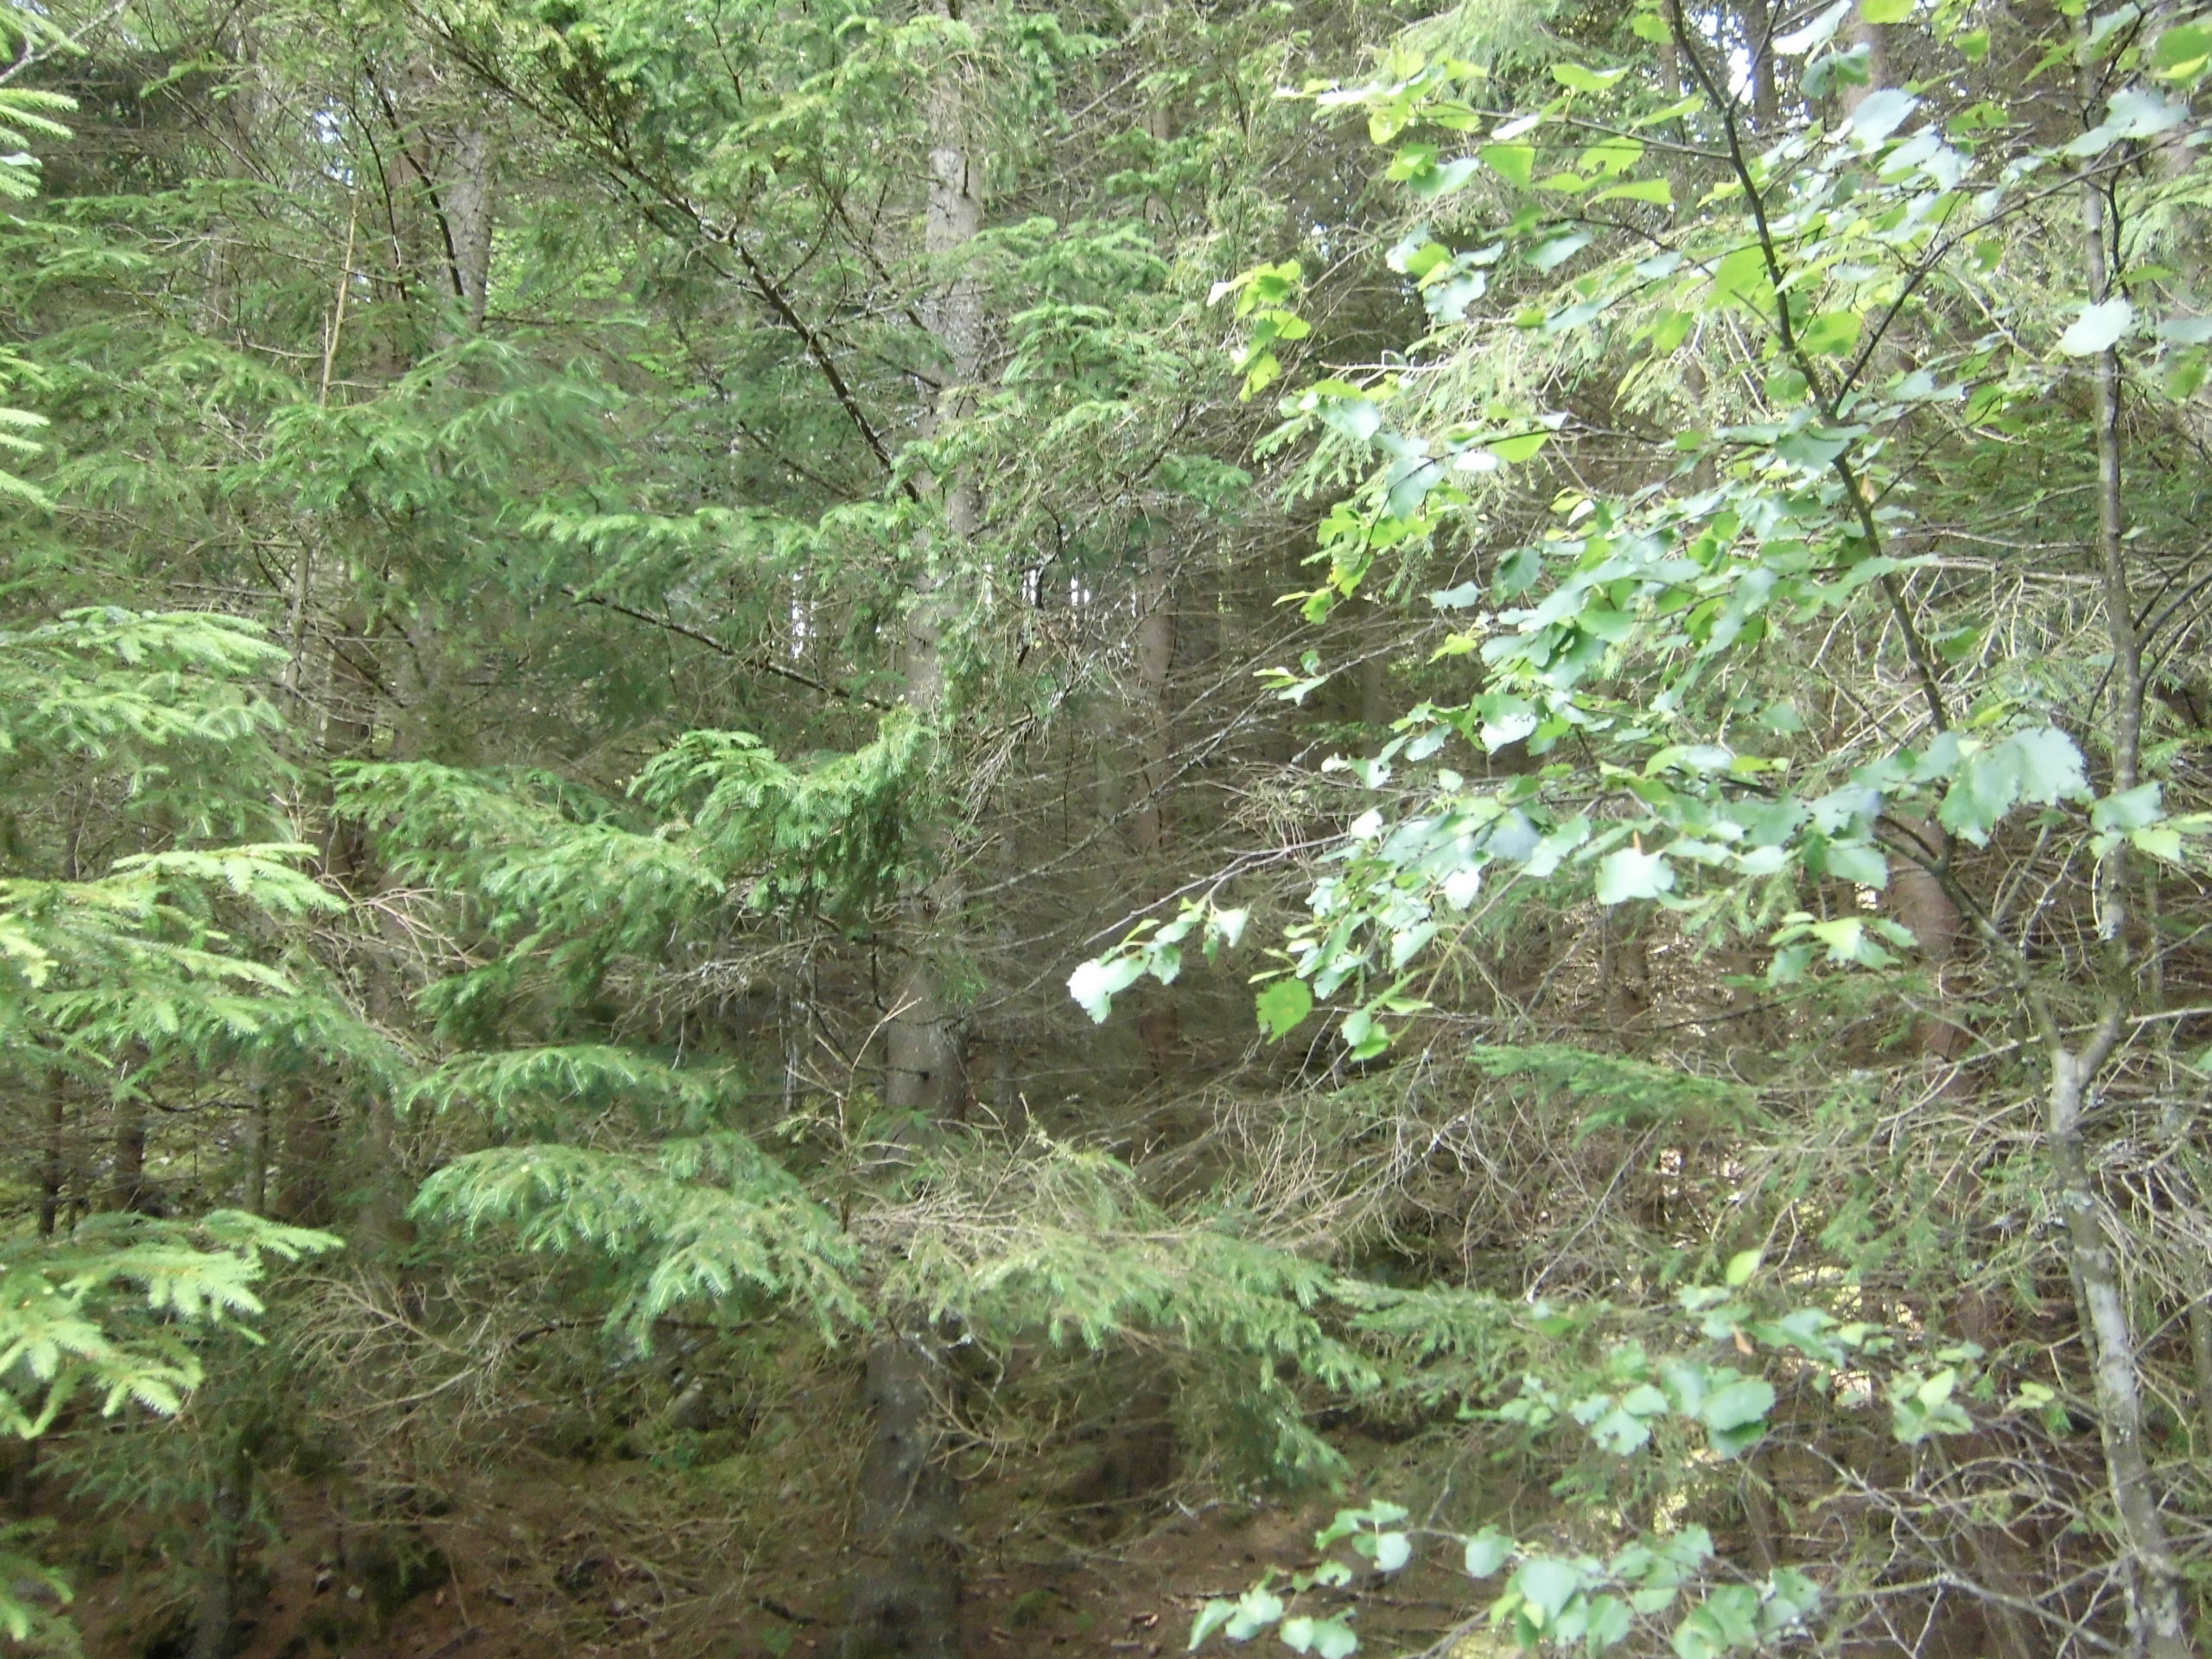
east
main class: Woodland
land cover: Spruce dominated coniferous woodland
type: boreal forest
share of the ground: 50 - 75 %
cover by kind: coniferous forest trees 55 %, herbaceous plants 15 %, lichens and mosses 15 %, shrubs 10 %, broadleaved forest trees 5 %
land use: Forestry
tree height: > 5 m
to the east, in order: Spruce dominated coniferous woodland; Spruce dominated mixed woodland; Broadleaved woodland; Spruce dominated mixed woodland; Spruce dominated coniferous woodland; Spruce dominated mixed woodland; Grassland with sparse tree/shrub cover; Spruce dominated mixed woodland; Grassland with sparse tree/shrub cover
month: July
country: SE
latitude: 57.3273
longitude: 15.1620
